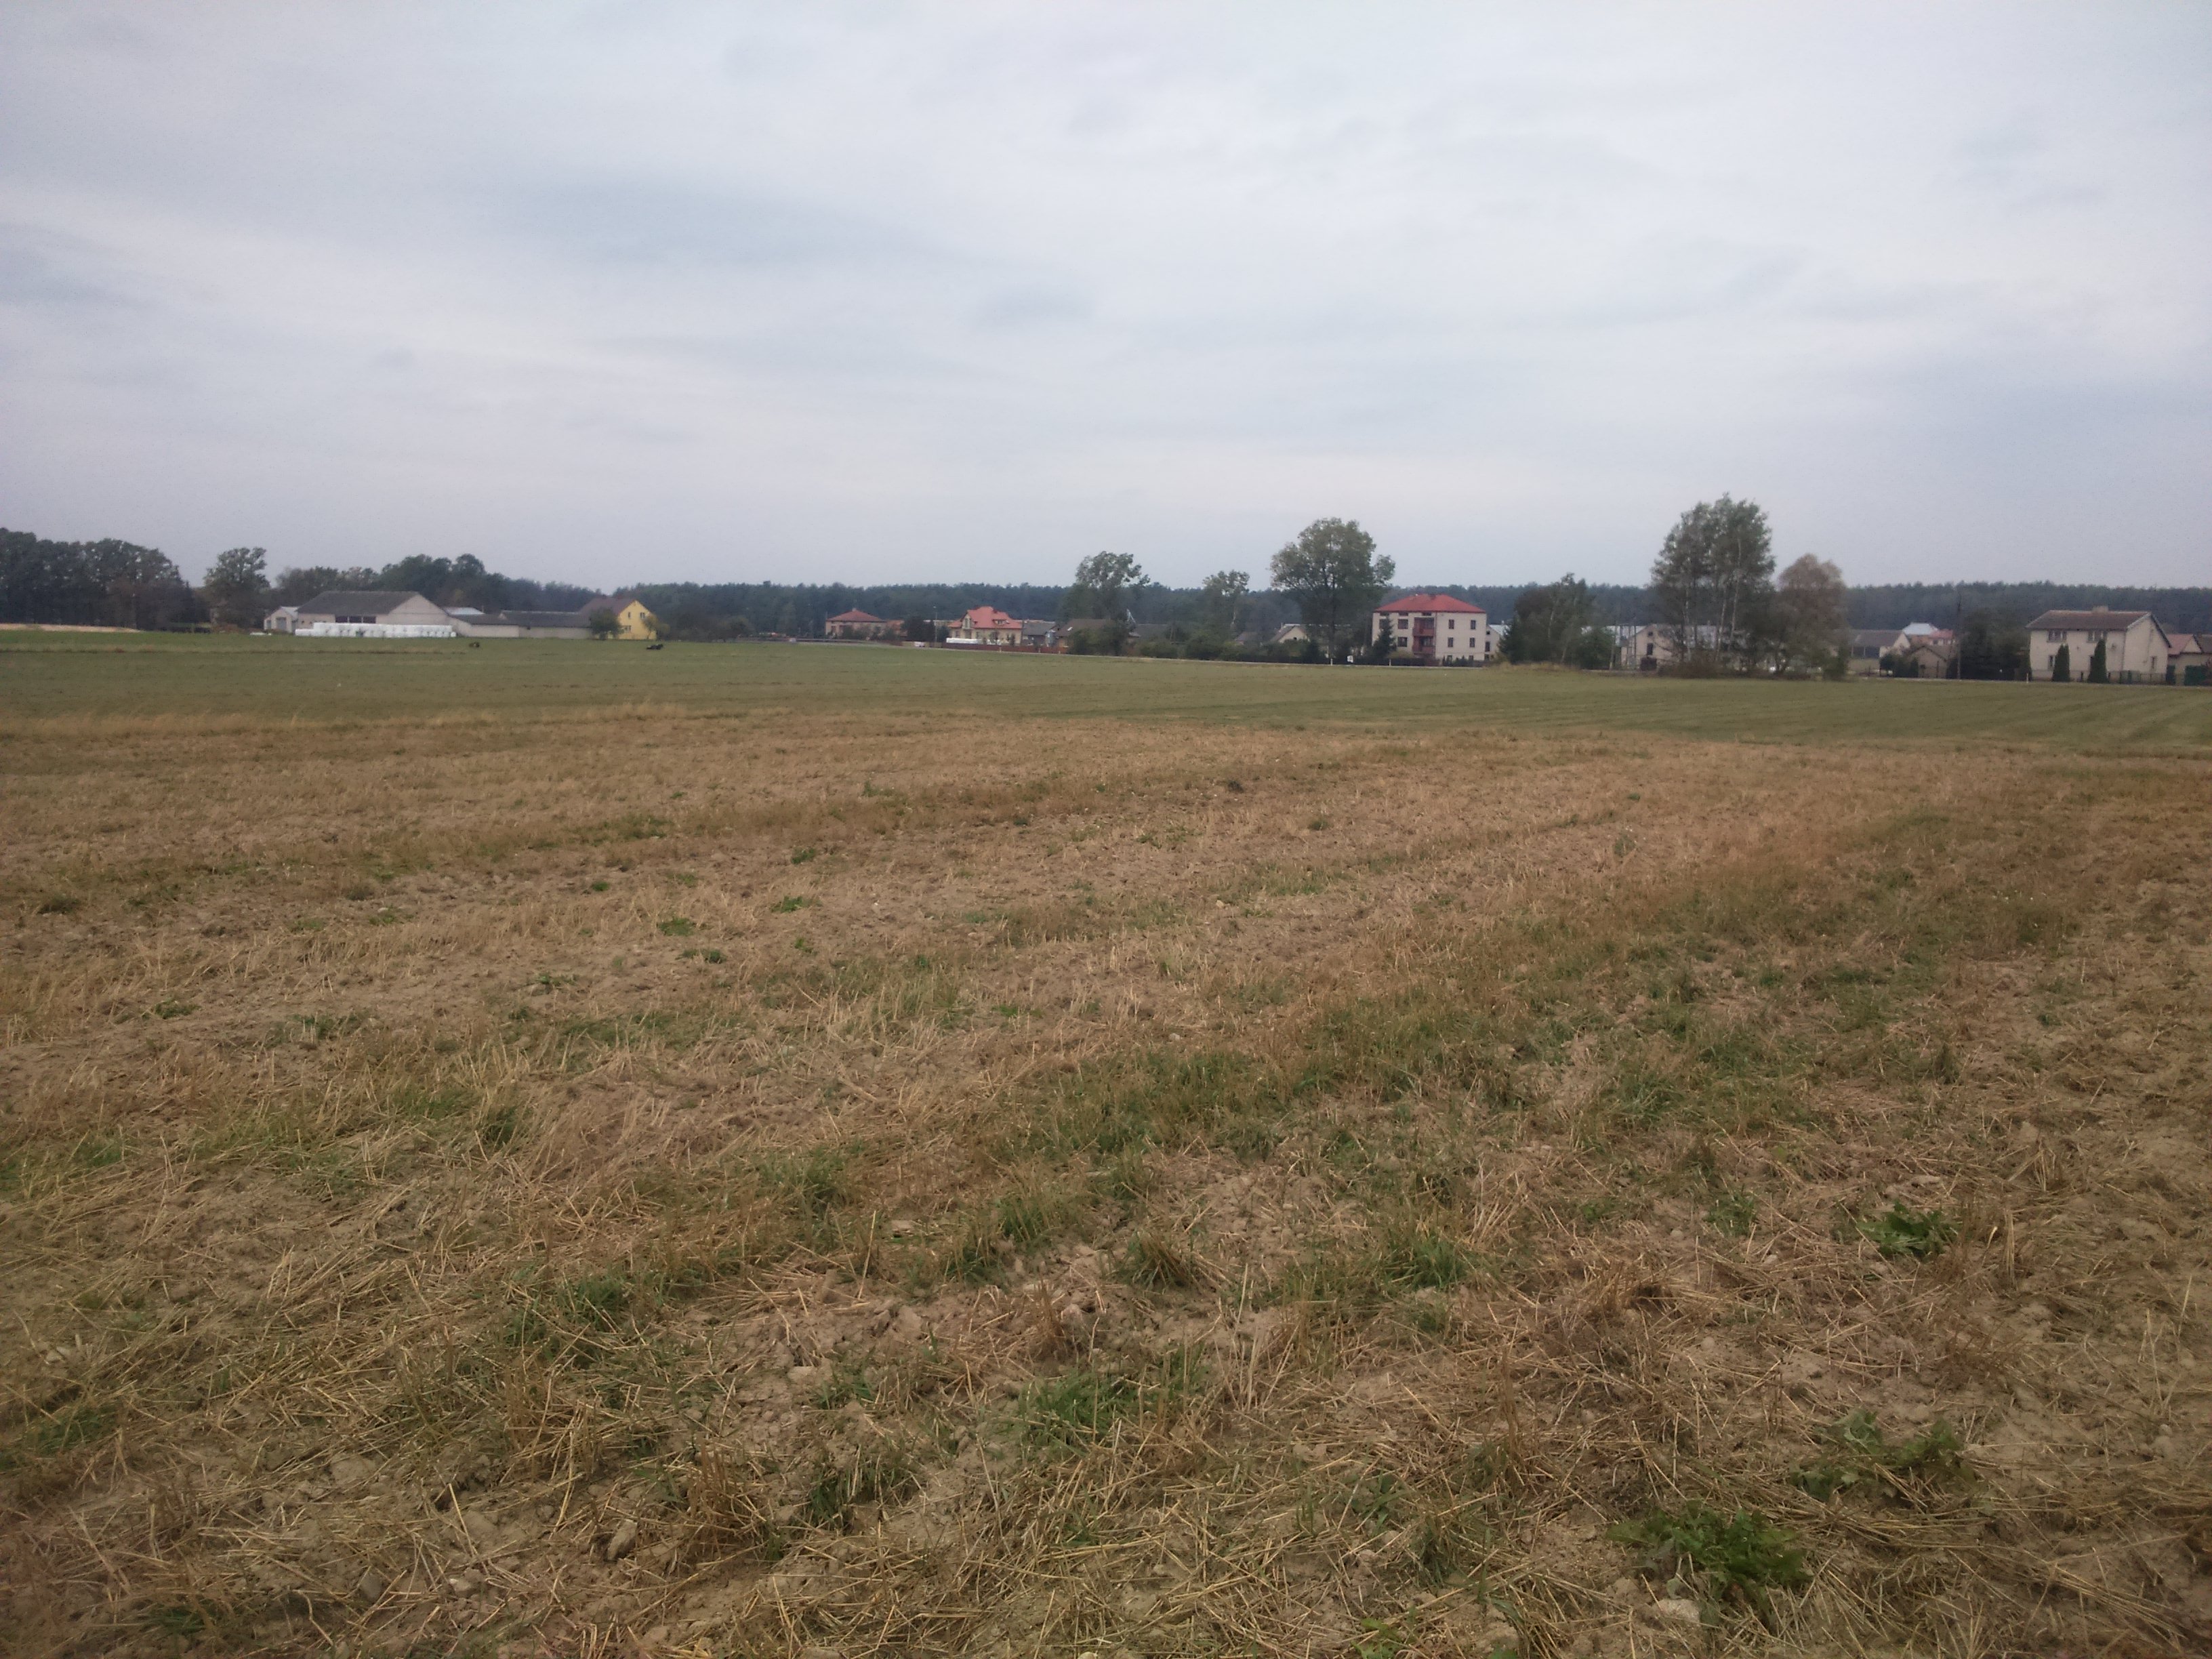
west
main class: Cropland
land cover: Common wheat
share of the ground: 25 - 50 %
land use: Agriculture (excluding fallow land and kitchen gardens)
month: October
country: PL
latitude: 52.7344
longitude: 22.3107
